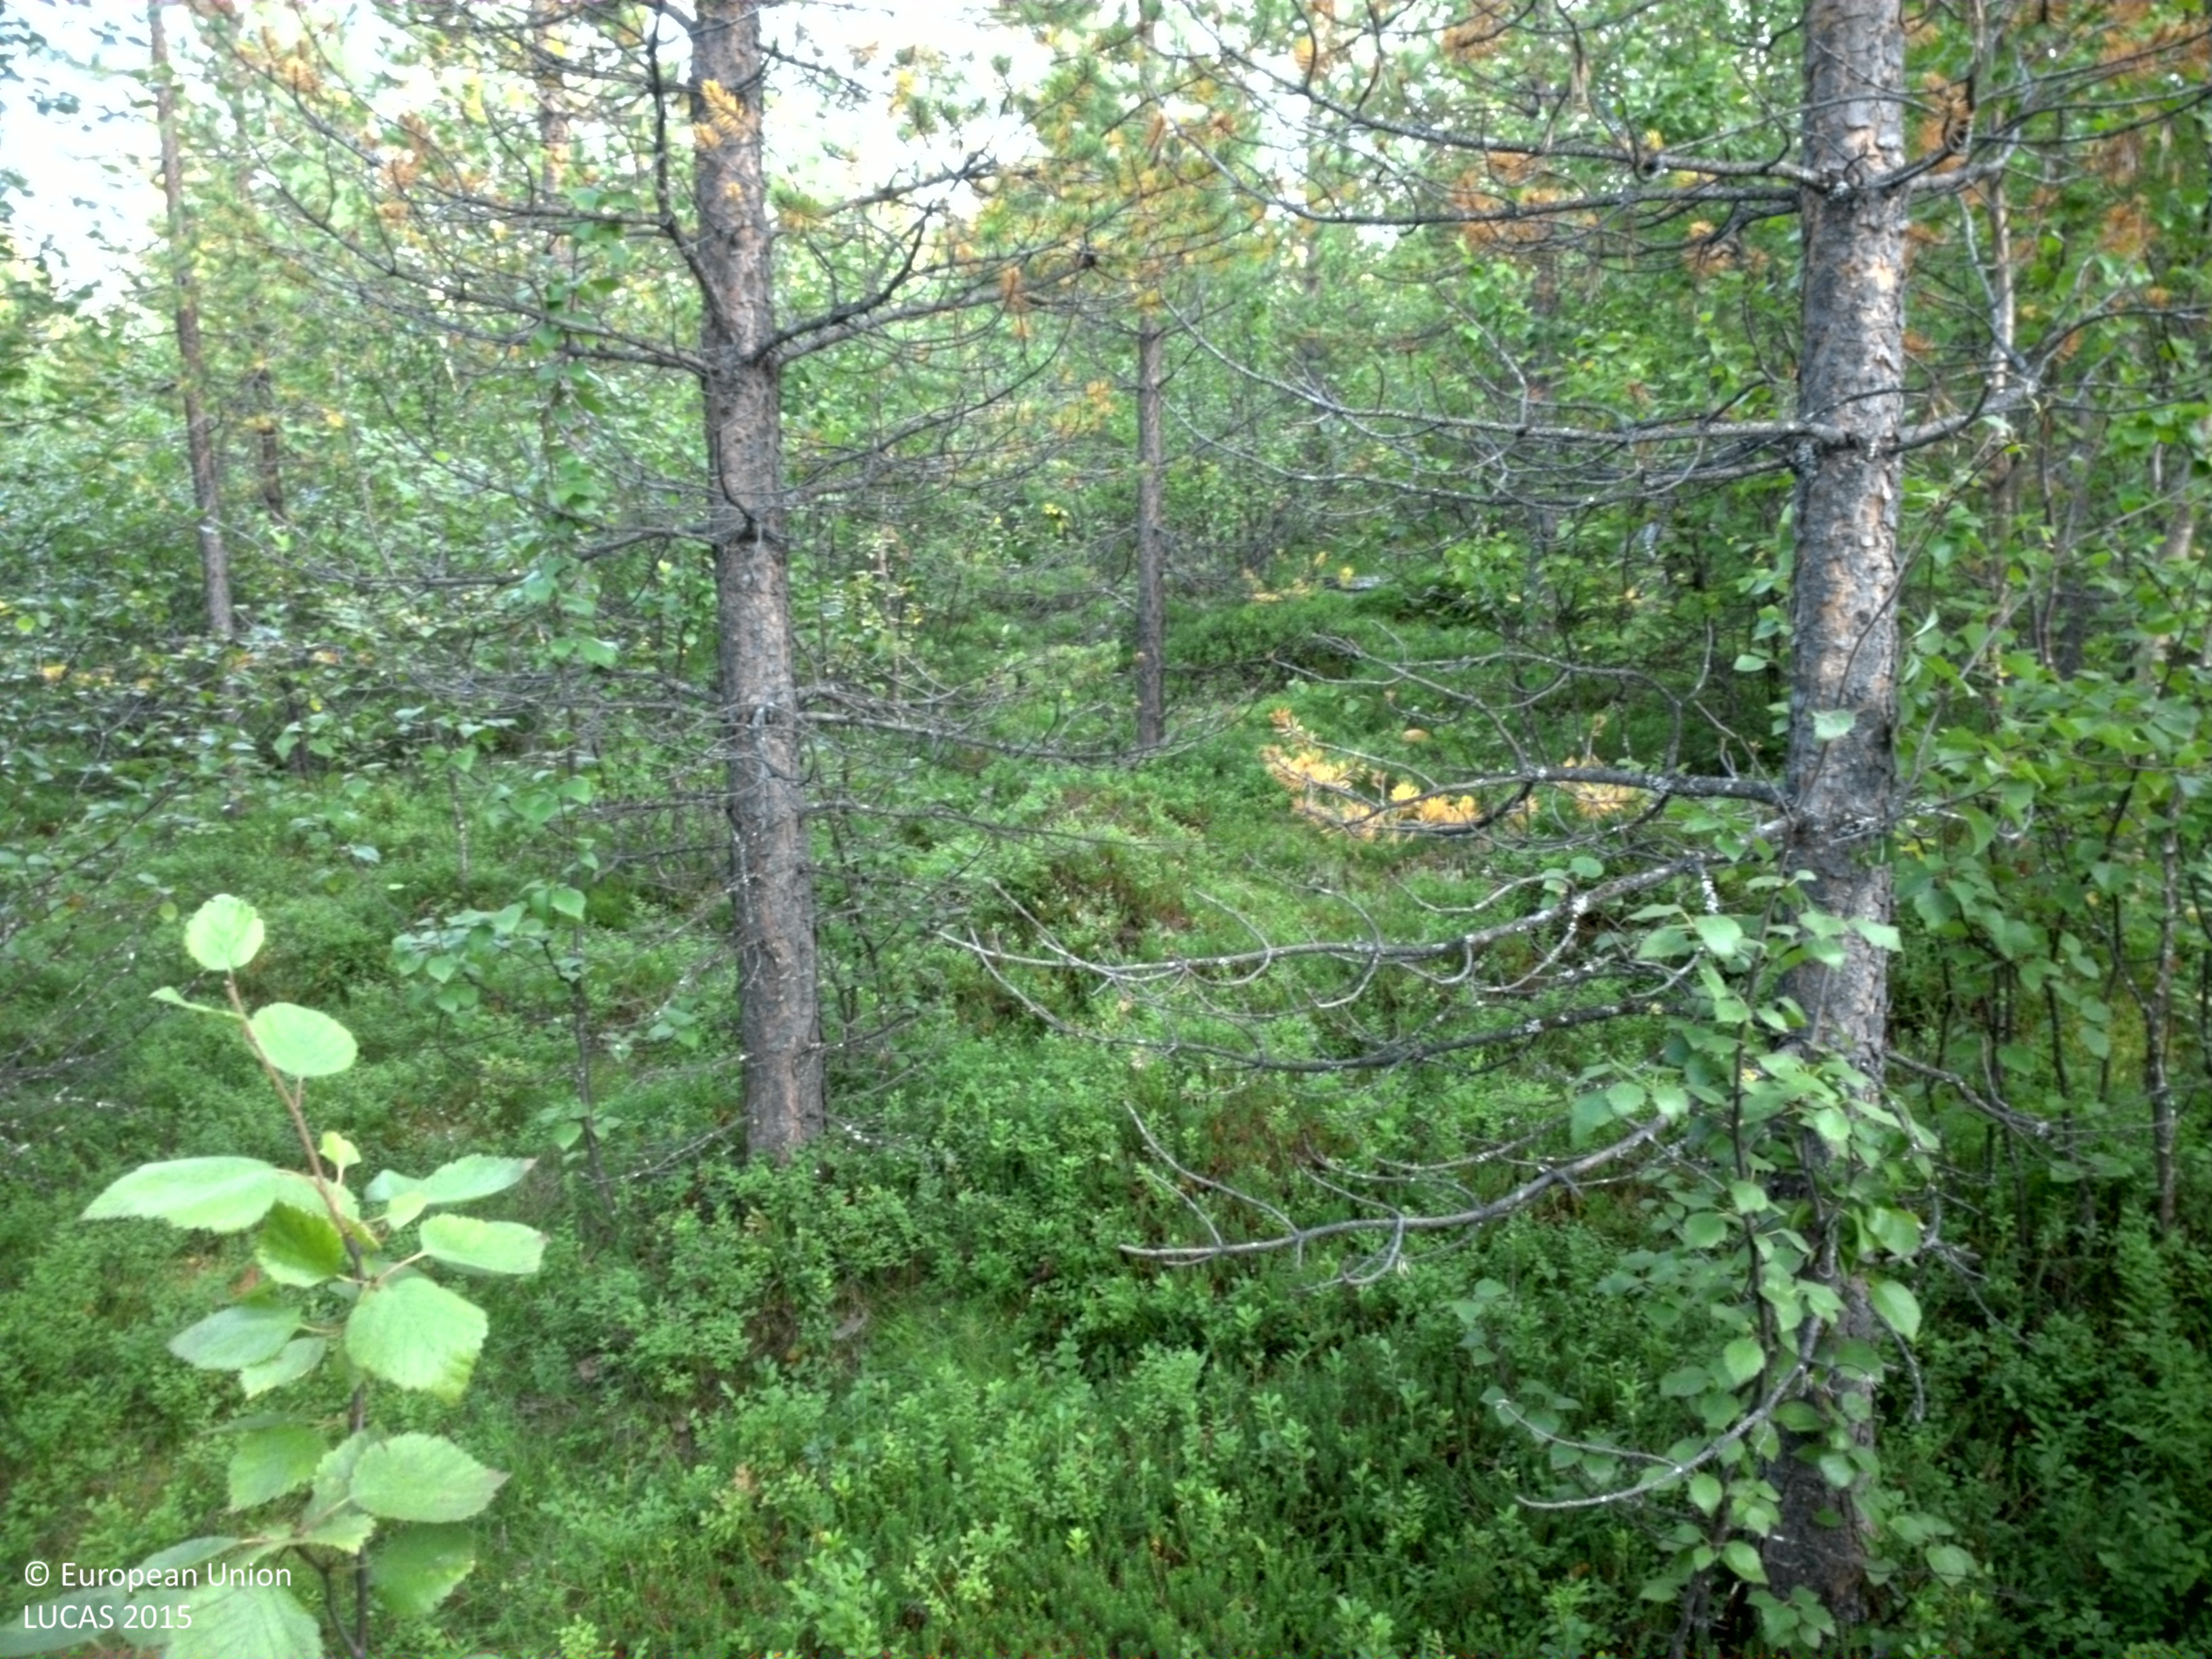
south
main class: Woodland
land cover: Pine dominated mixed woodland
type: boreal forest
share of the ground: 50 - 75 %
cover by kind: broadleaved forest trees 50 %, shrubs 30 %, coniferous forest trees 20 %
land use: Forestry
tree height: > 5 m
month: August
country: SE
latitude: 66.6684
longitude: 19.1139
